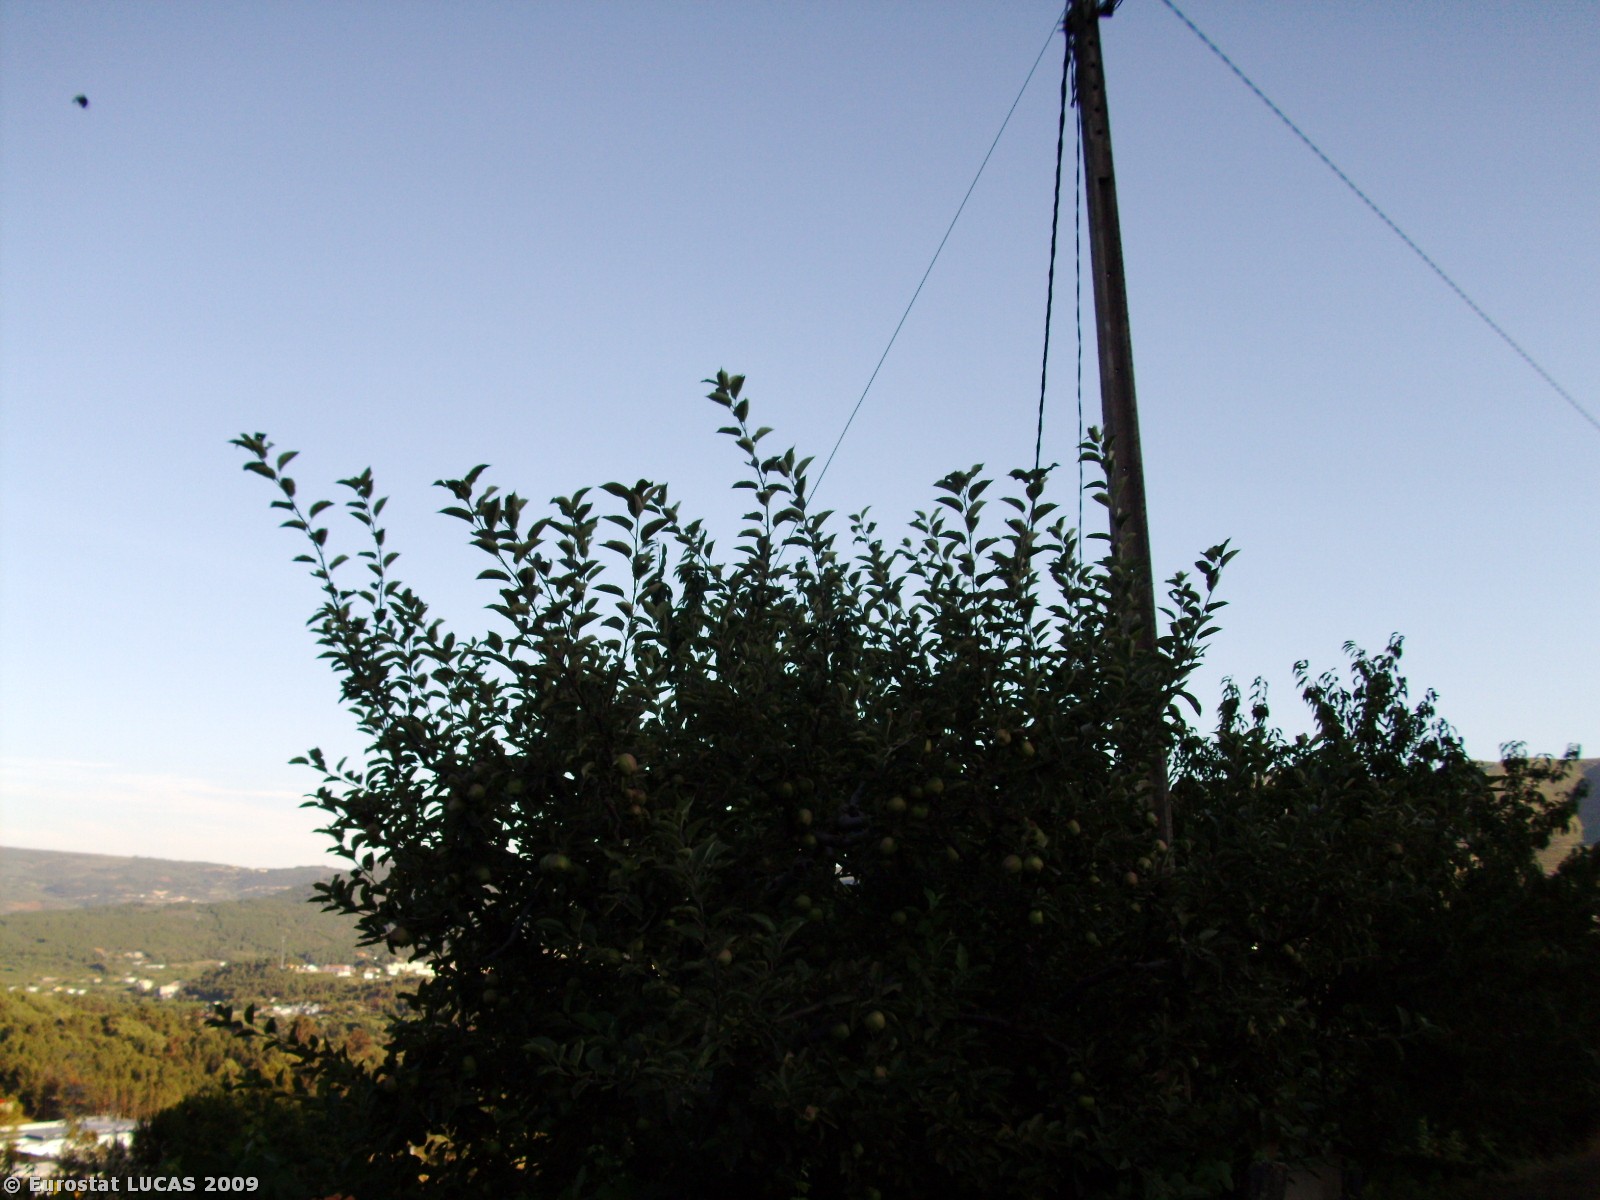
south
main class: Cropland
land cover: Vineyards
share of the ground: 25 - 50 %
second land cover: Bare land
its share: > 75 %
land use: Agriculture (excluding fallow land and kitchen gardens)
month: July
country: PT
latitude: 41.0449
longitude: -7.7941
